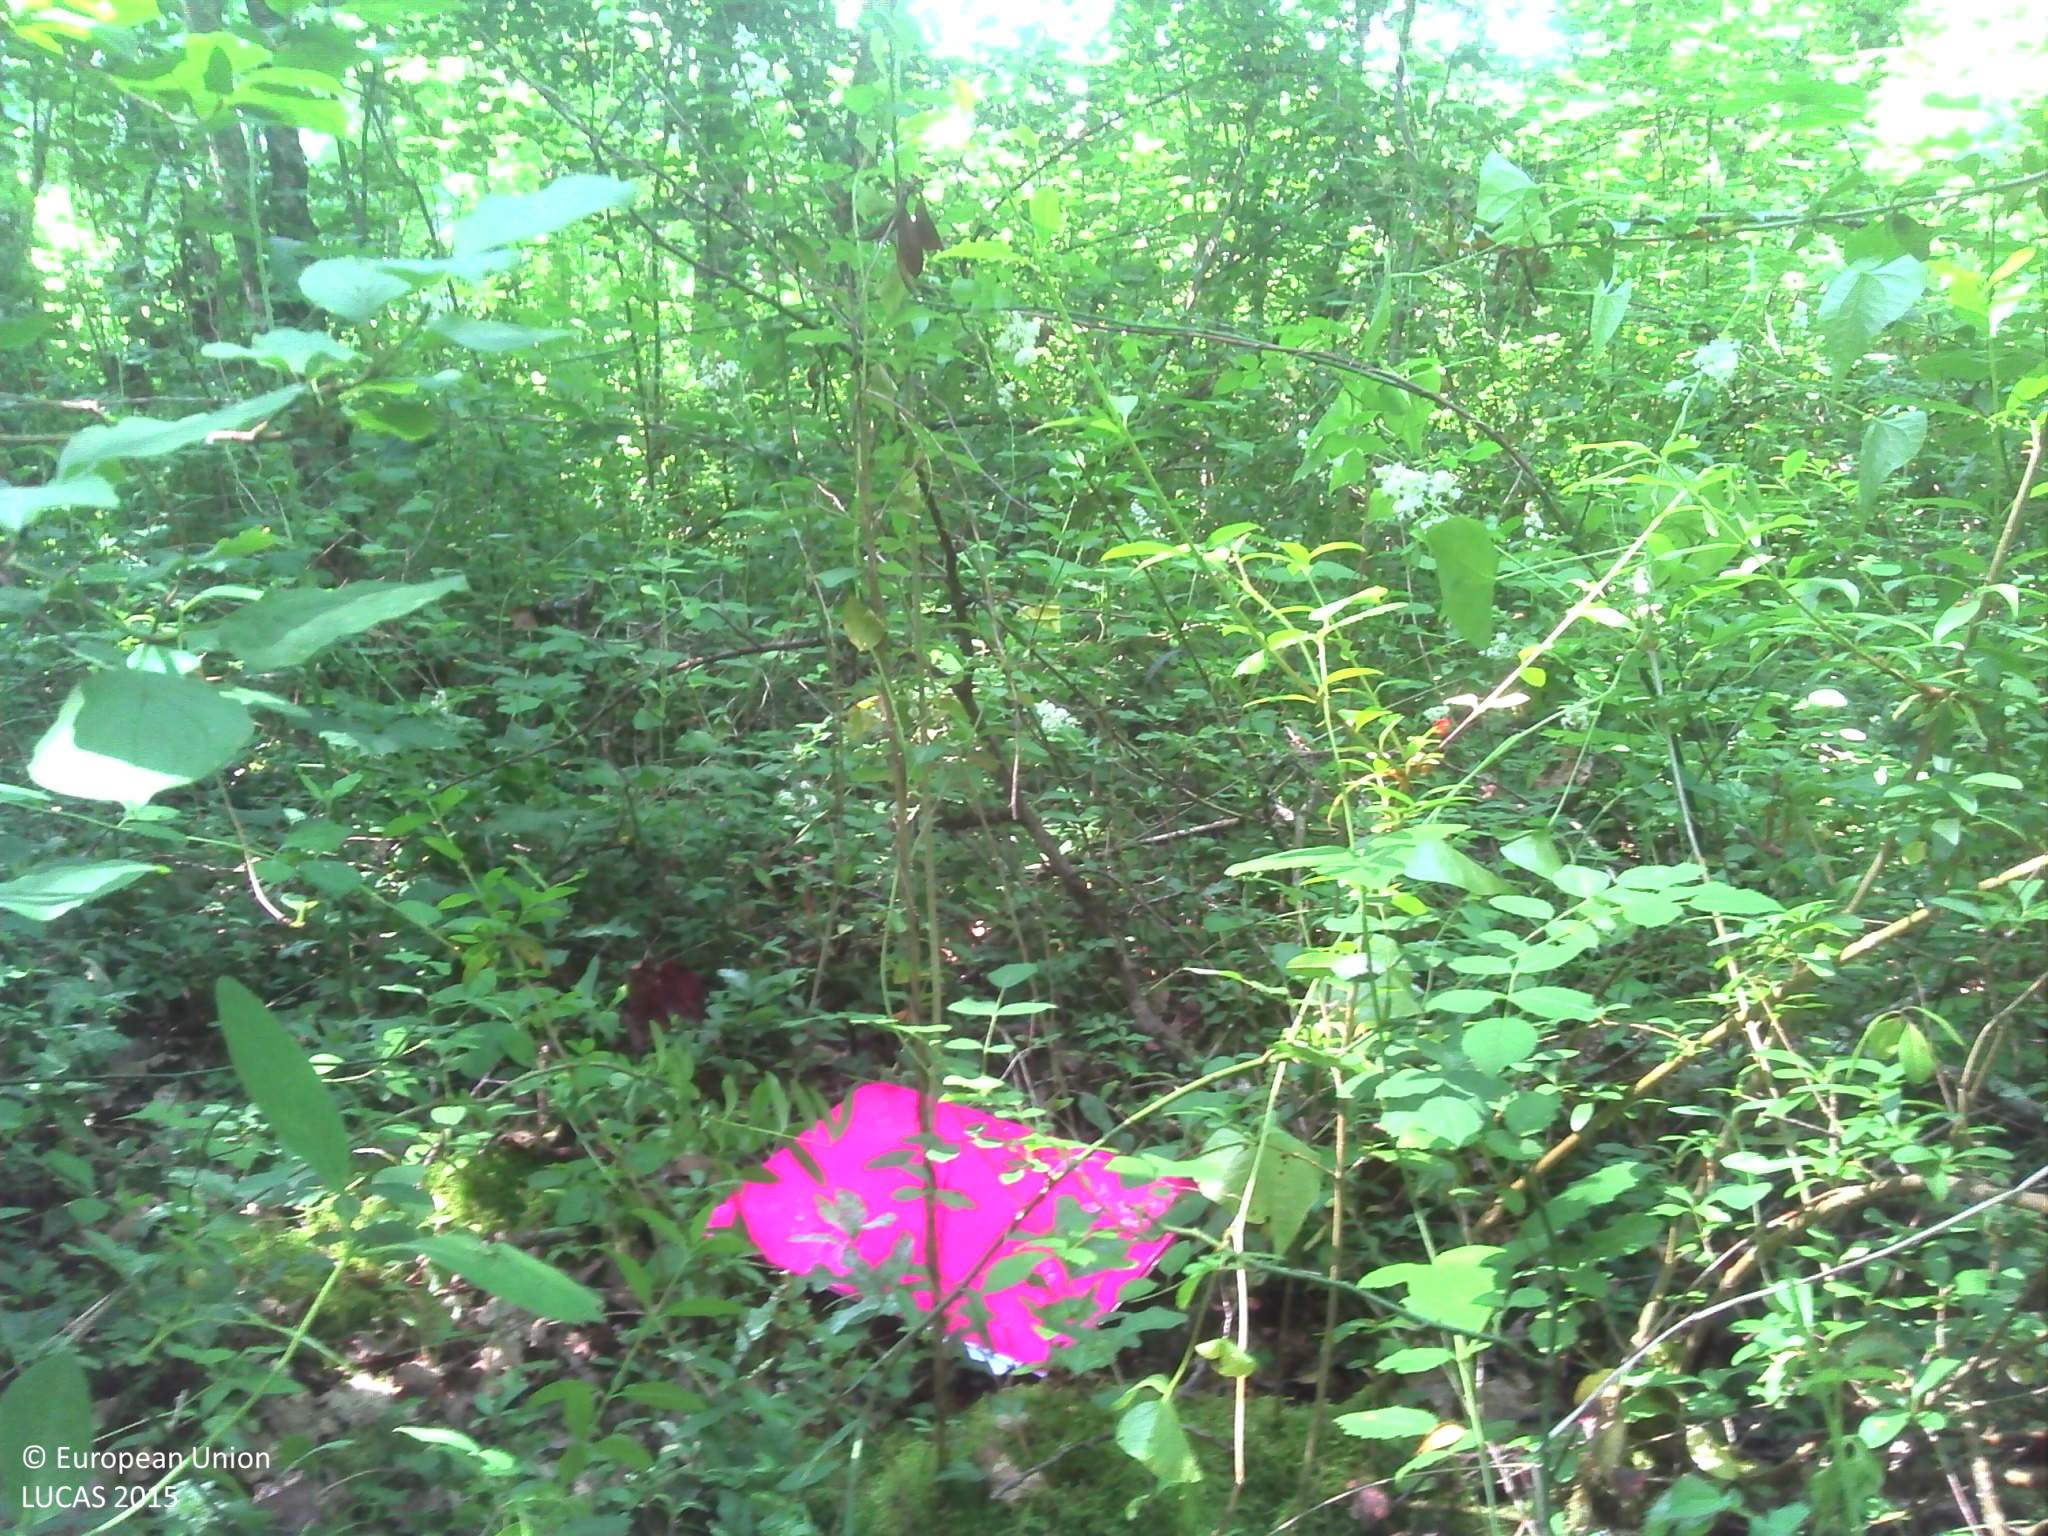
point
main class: Woodland
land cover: Broadleaved woodland
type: mesophytic deciduous forest
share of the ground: > 75 %
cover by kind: broadleaved forest trees 100 %
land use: Forestry
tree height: > 5 m
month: June
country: FR
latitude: 43.8566
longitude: 1.9542
